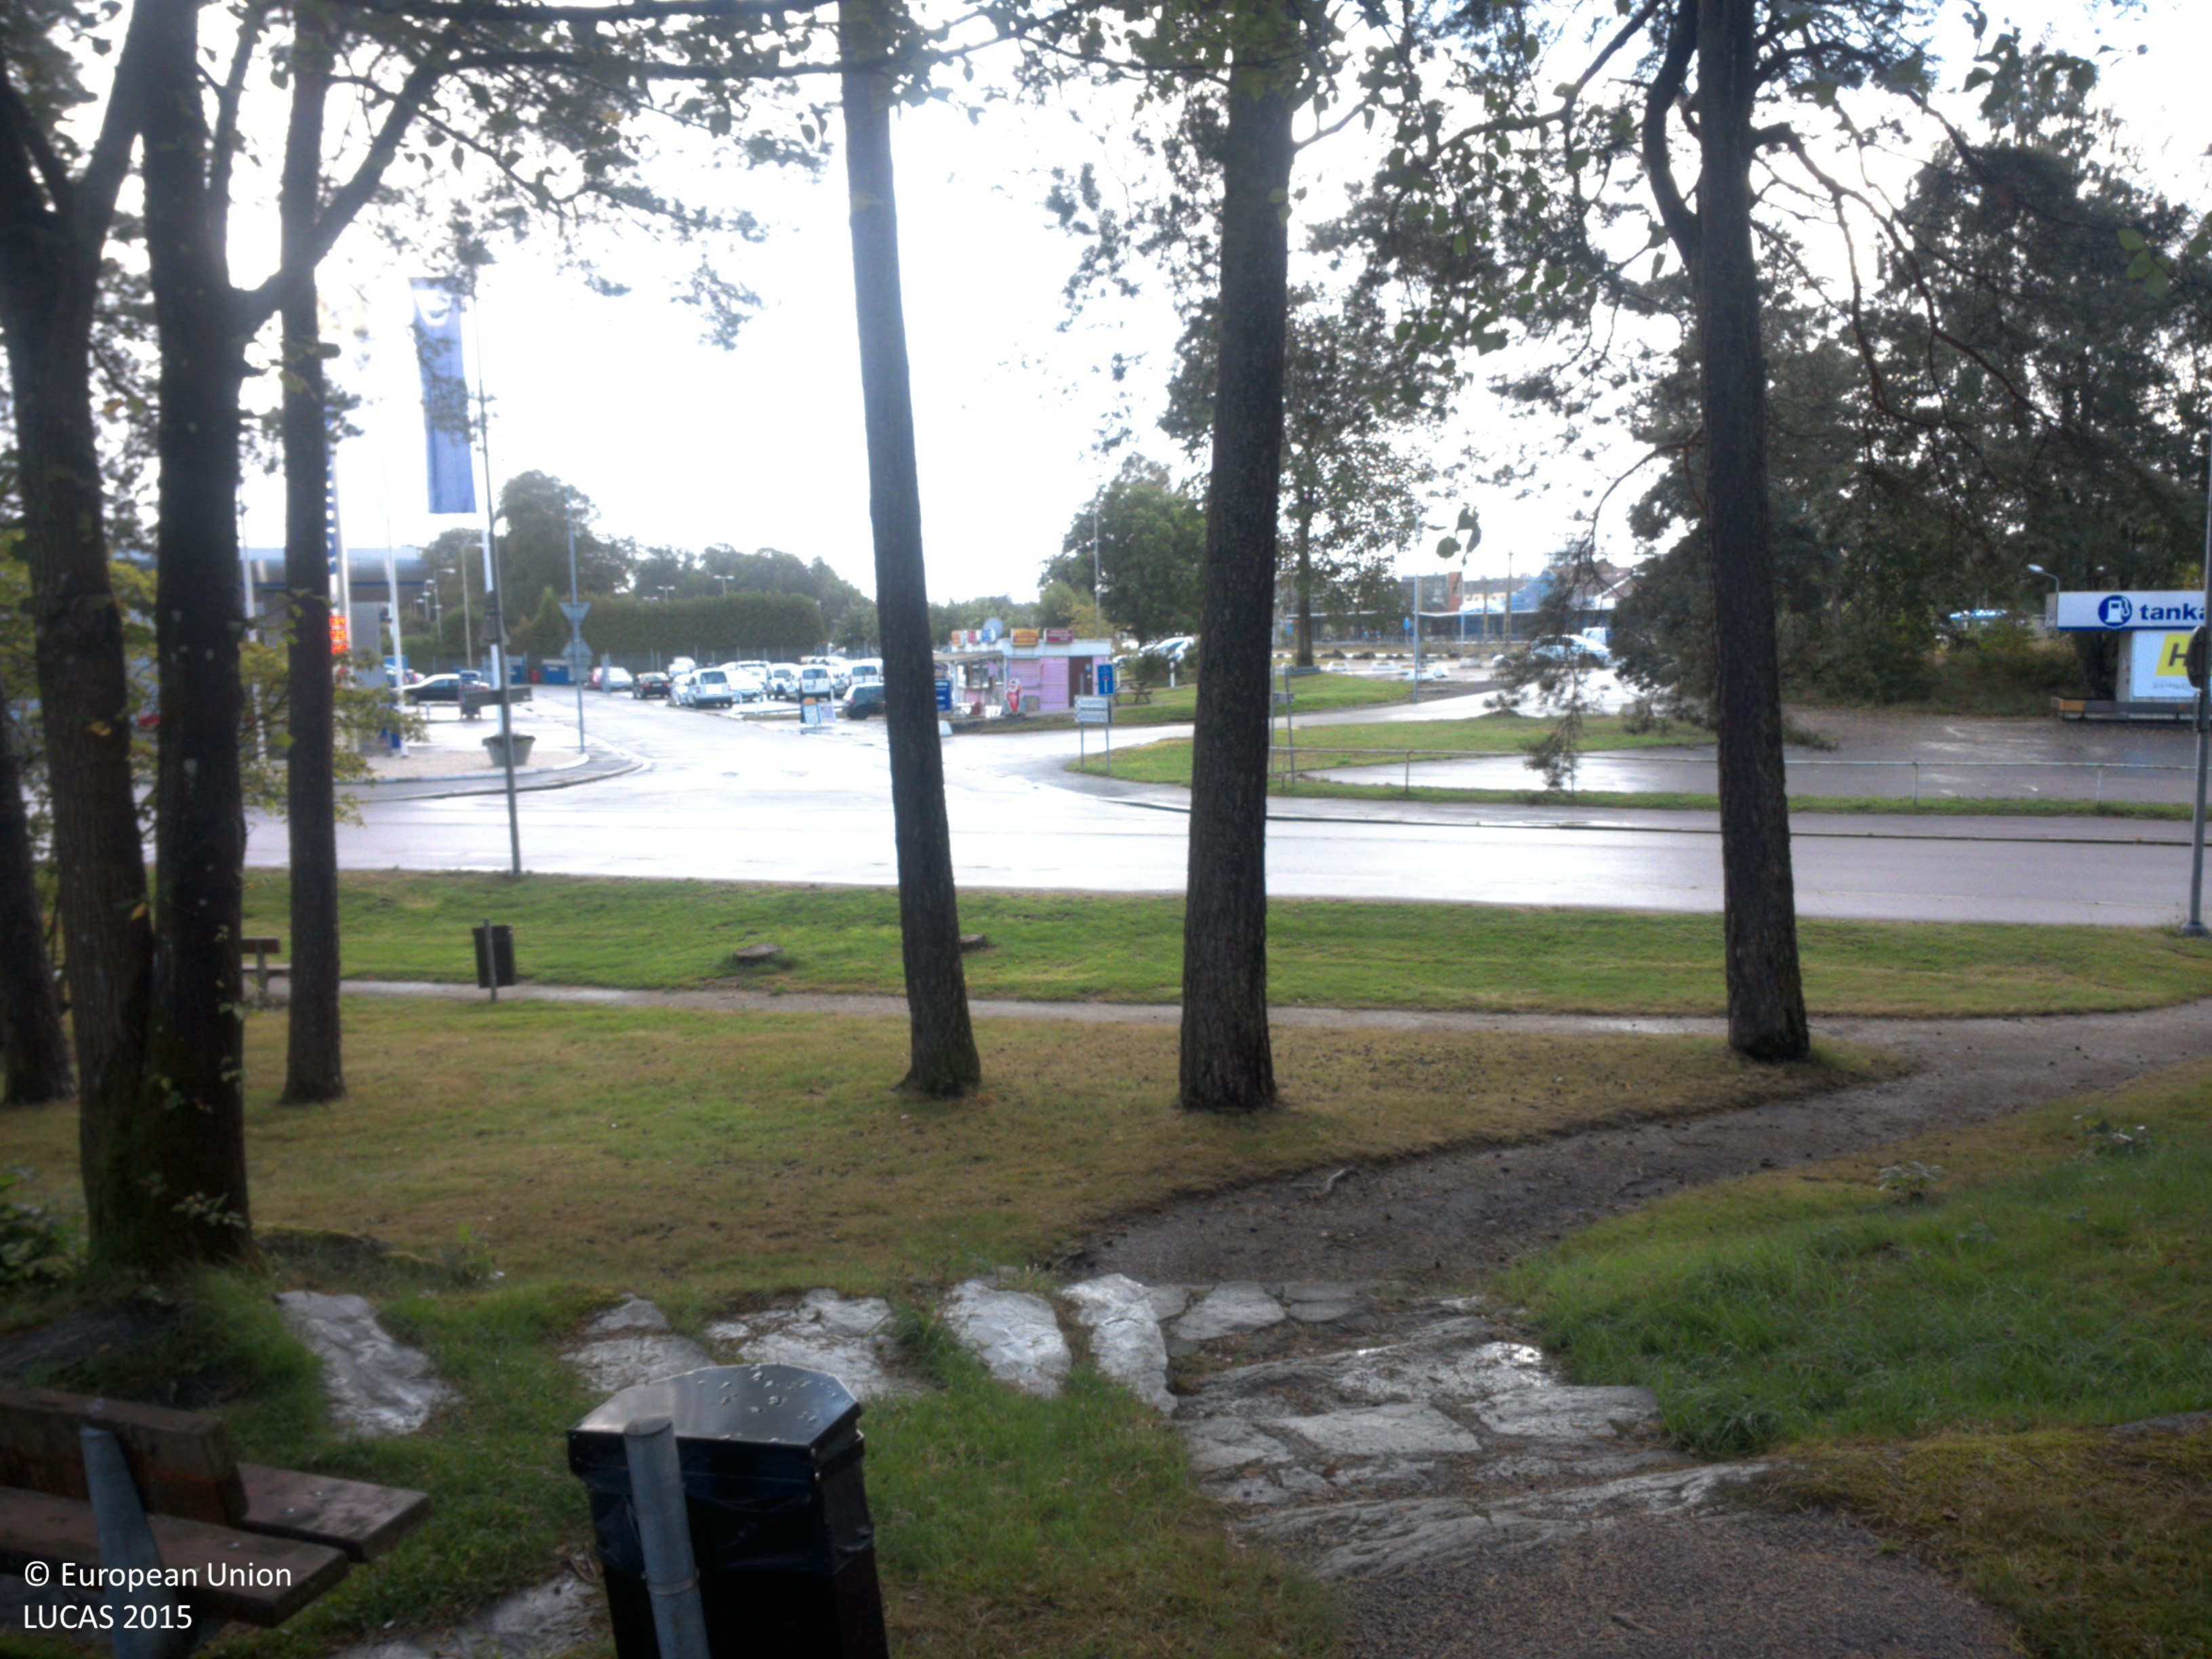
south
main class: Woodland
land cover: Pine dominated coniferous woodland
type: boreal forest
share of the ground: 50 - 75 %
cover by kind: coniferous forest trees 60 %, herbaceous plants 40 %
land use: Amenities, museums, leisure
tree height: > 5 m
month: August
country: SE
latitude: 58.2898
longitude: 12.2983
